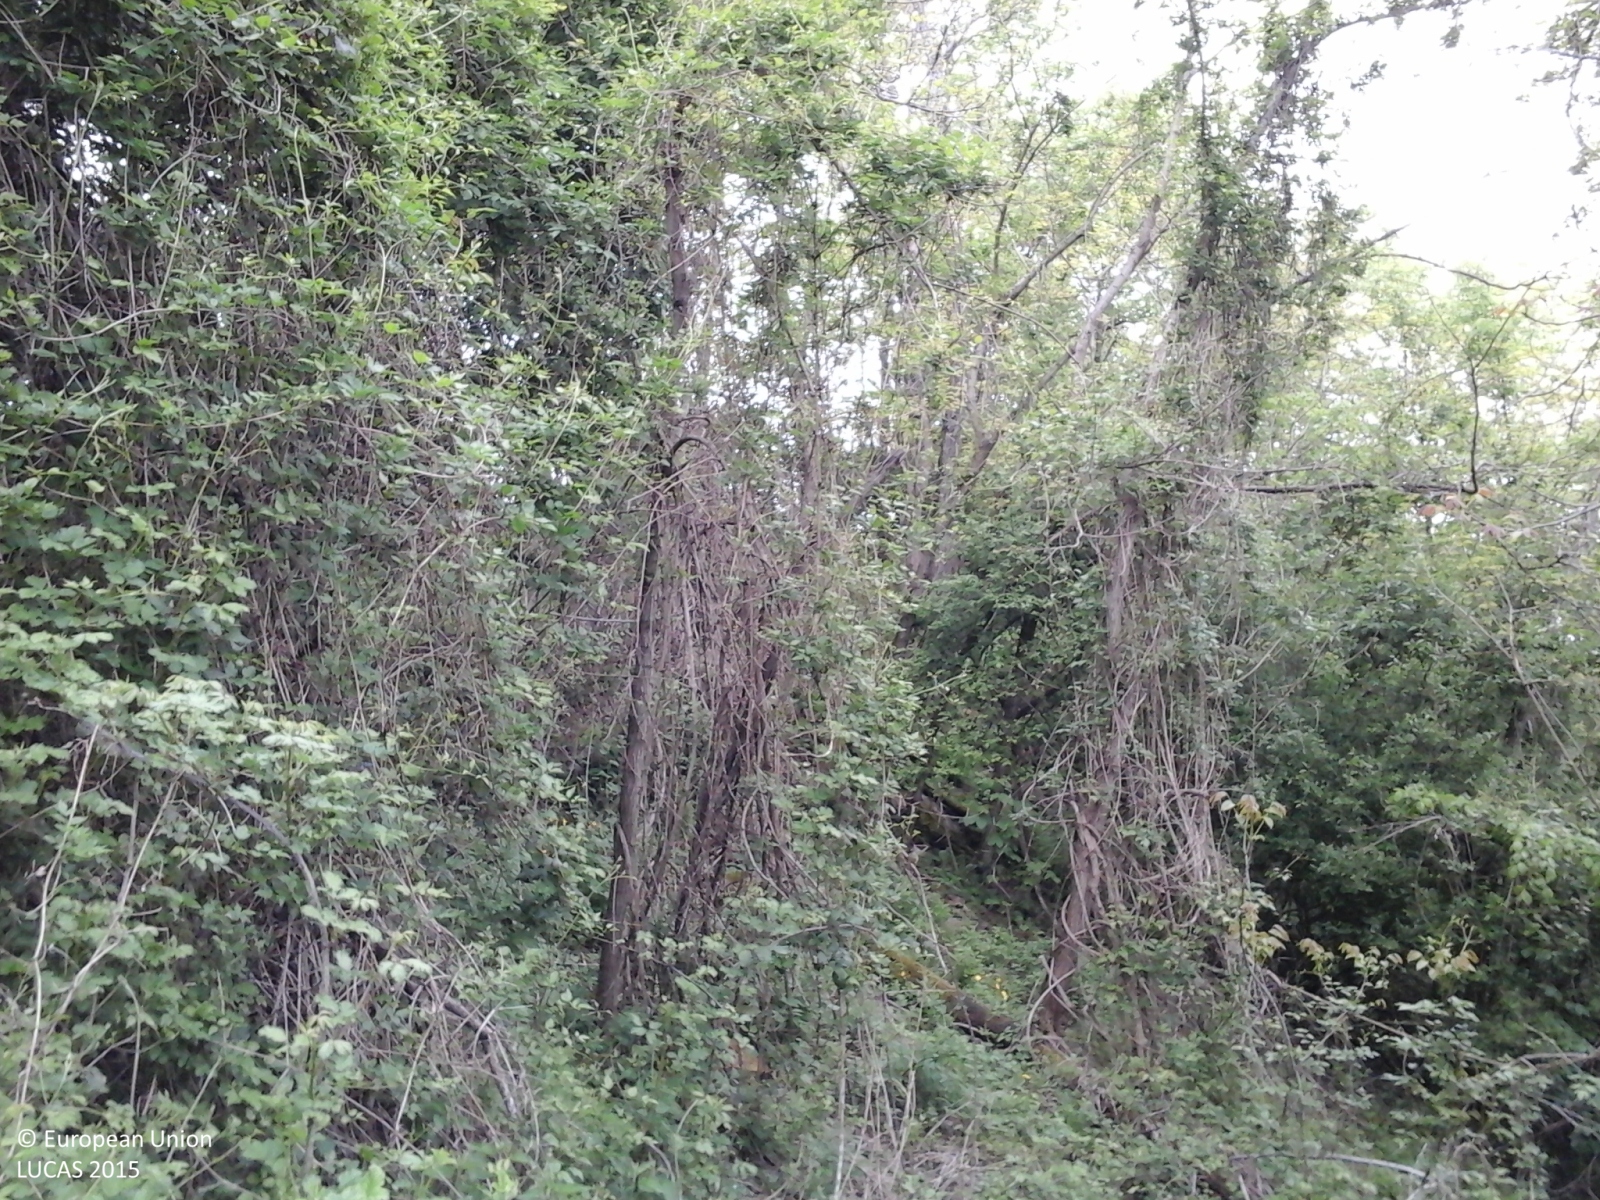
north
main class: Woodland
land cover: Broadleaved woodland
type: mesophytic deciduous forest
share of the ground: > 75 %
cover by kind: broadleaved forest trees 100 %
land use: Forestry
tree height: > 5 m
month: April
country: IT
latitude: 44.8538
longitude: 9.4065
